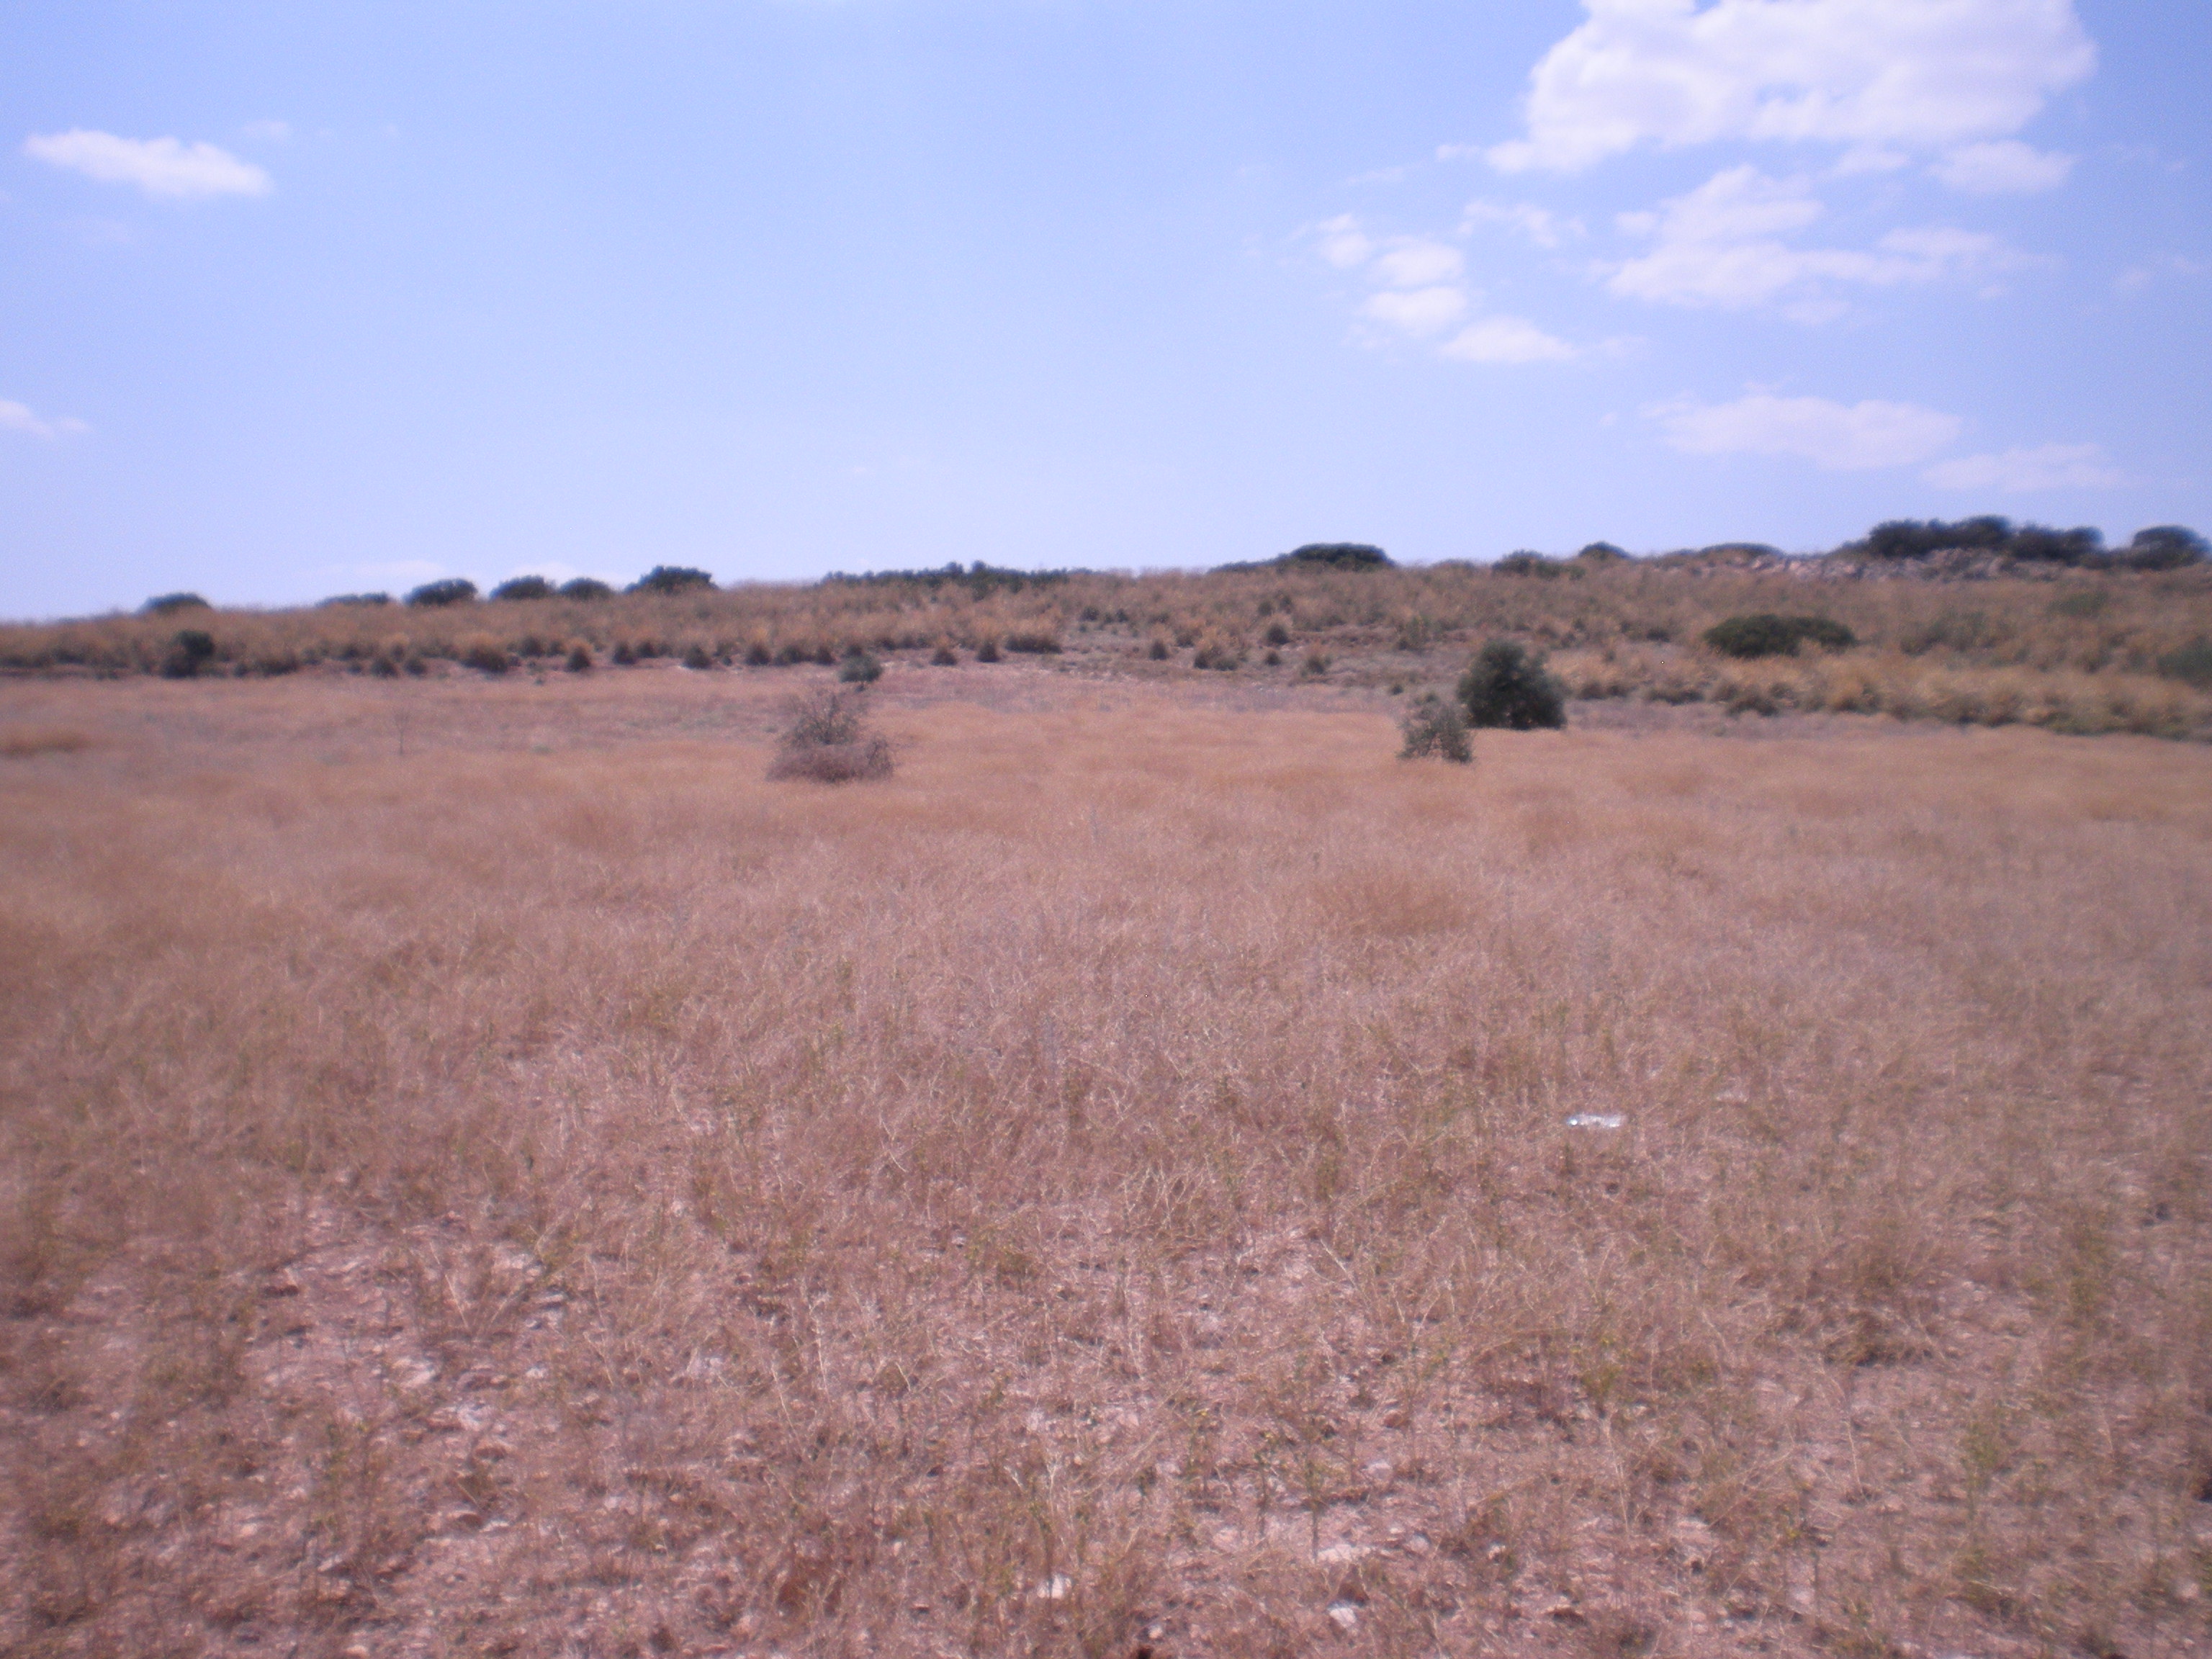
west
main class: Grassland
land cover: Spontaneously vegetated surfaces
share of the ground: 25 - 50 %
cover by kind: unconsolidated bare surface 70 %, herbaceous plants 30 %
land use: Abandoned areas
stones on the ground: < 10 %
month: June
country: ES
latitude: 39.6236
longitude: -3.3615
